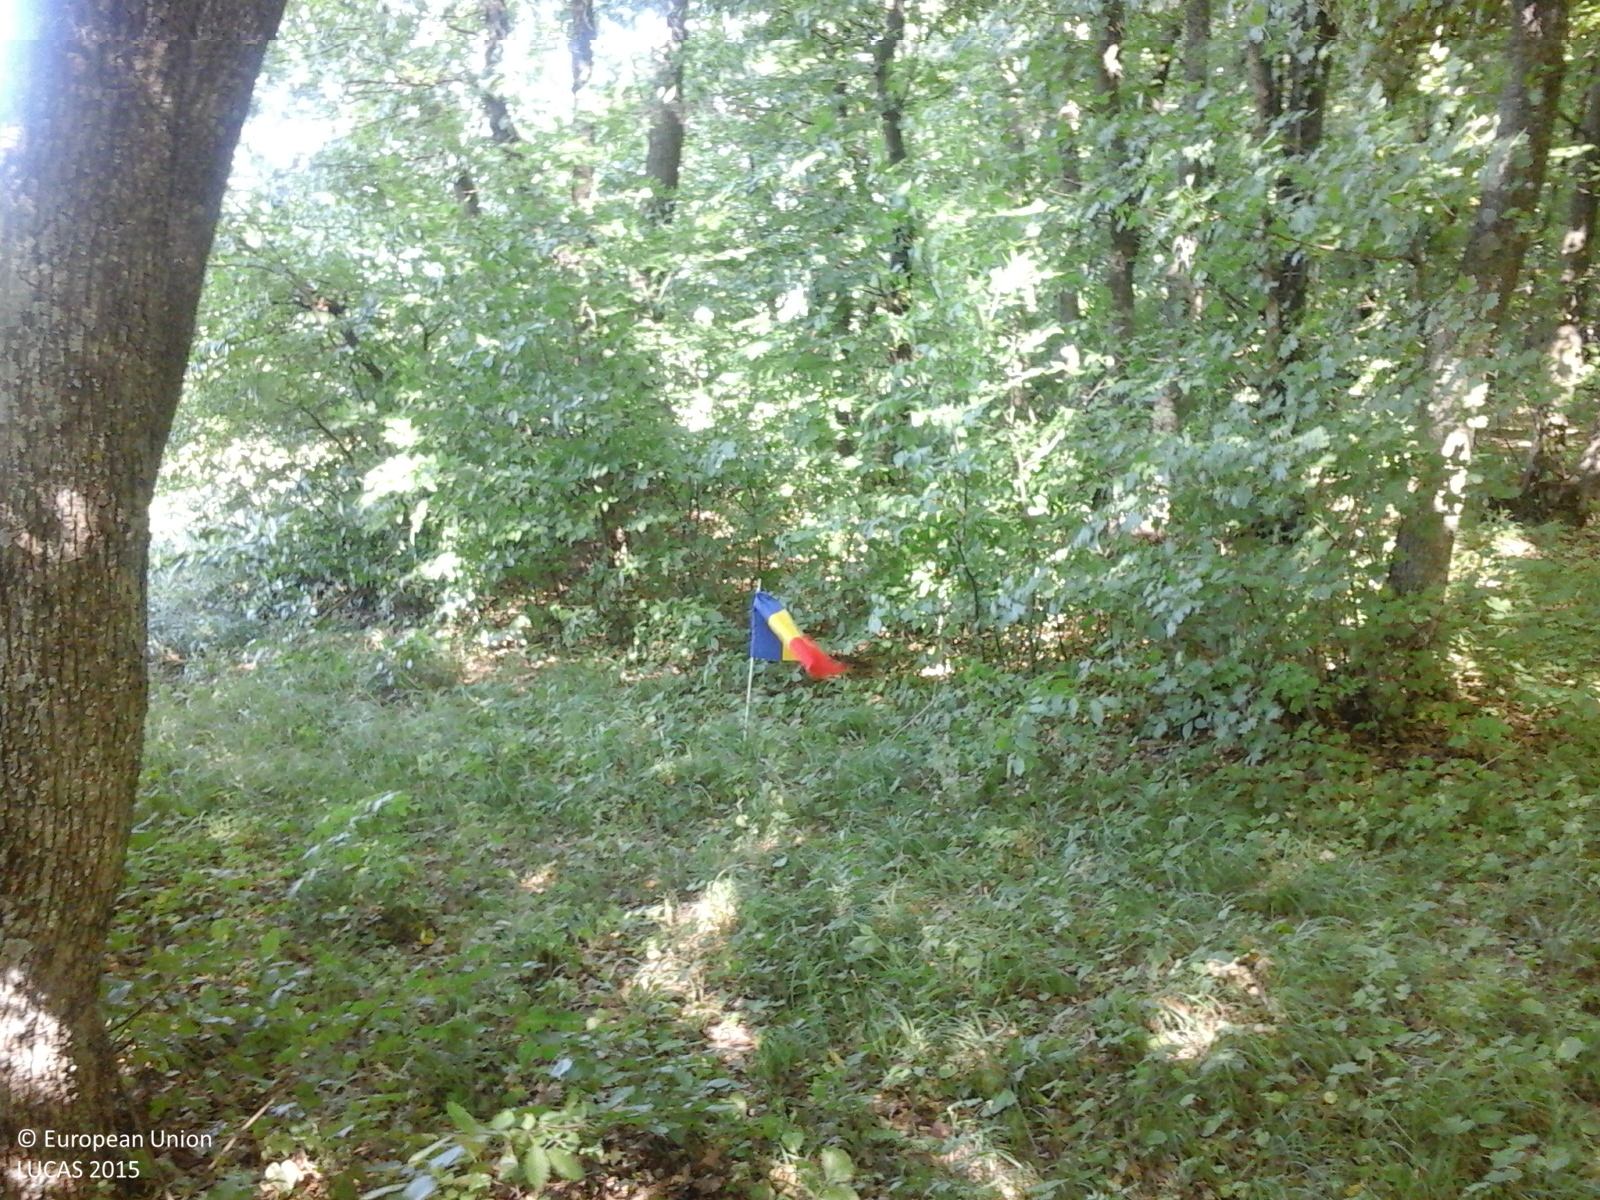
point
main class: Woodland
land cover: Broadleaved woodland
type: acidophilous oak and oak-birch forest
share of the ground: > 75 %
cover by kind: broadleaved forest trees 85 %, herbaceous plants 10 %, shrubs 5 %
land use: Forestry
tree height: > 5 m
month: June
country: RO
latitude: 46.7619
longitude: 28.0008
